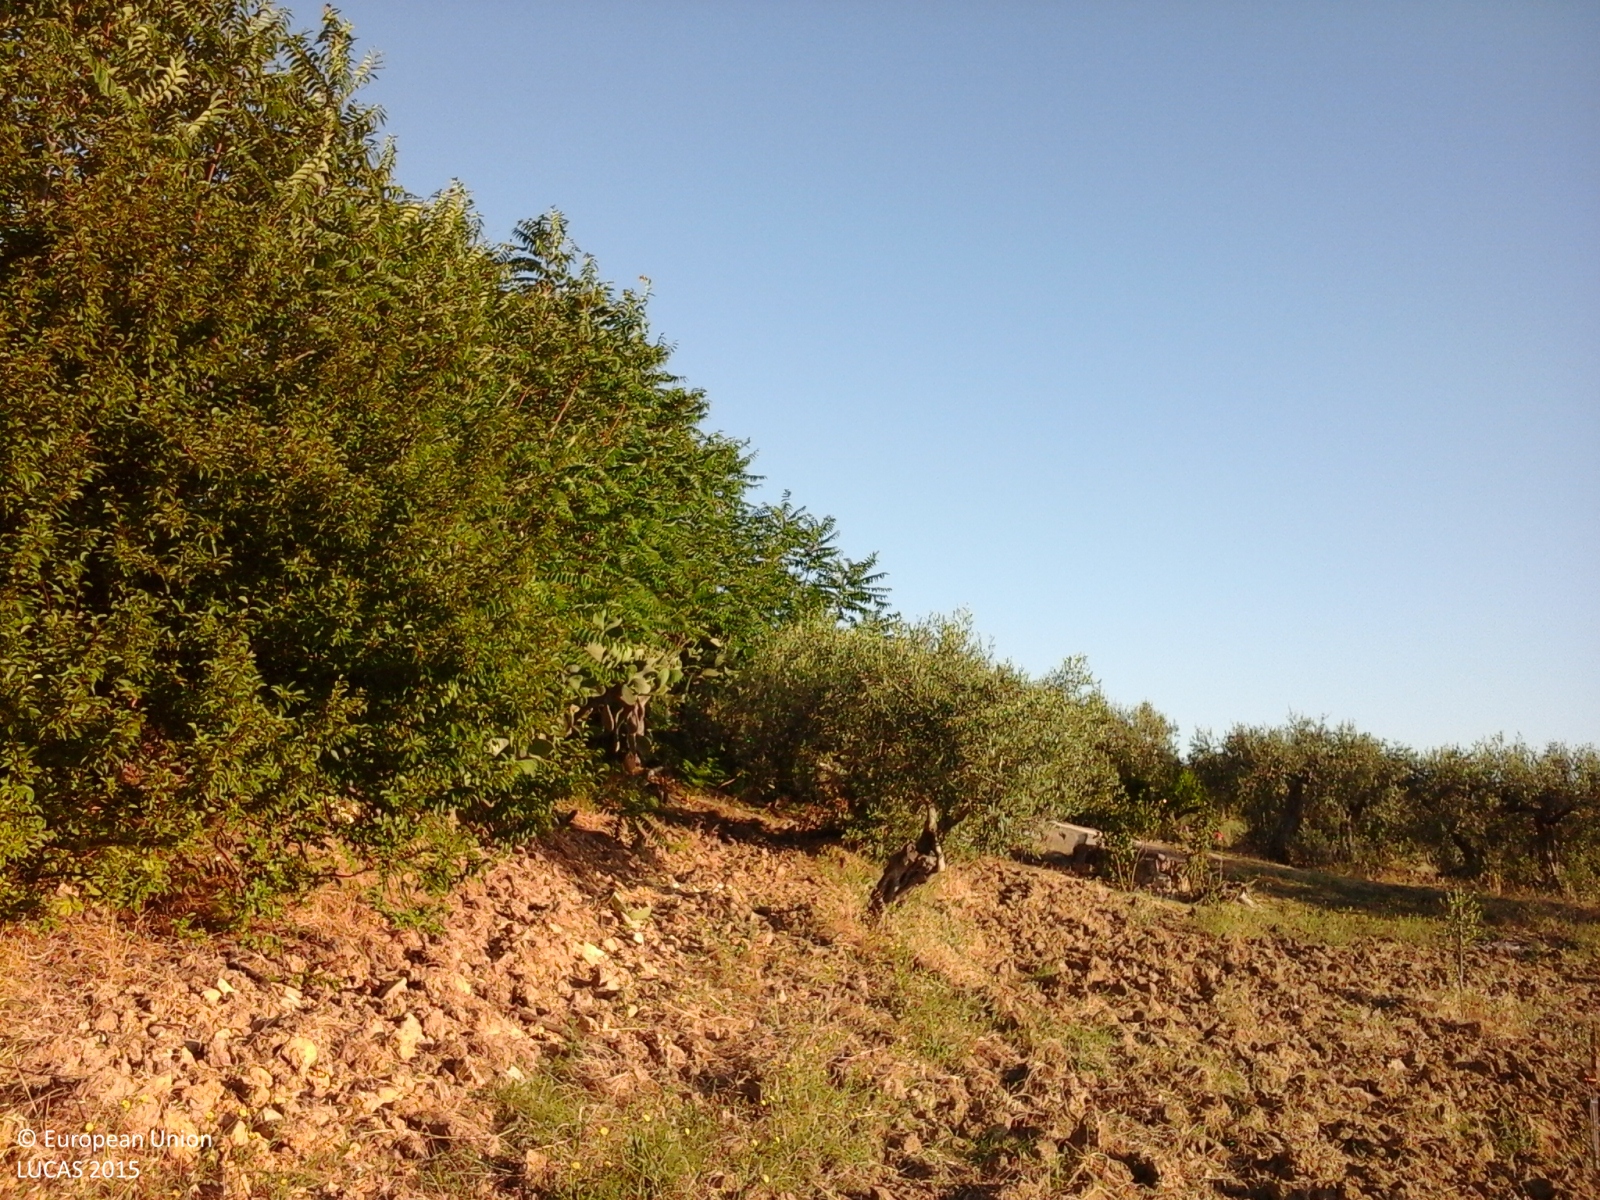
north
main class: Cropland
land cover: Olive groves
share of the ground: 10 - 25 %
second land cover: Other bare soil
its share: > 75 %
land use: Agriculture (excluding fallow land and kitchen gardens)
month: June
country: IT
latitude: 37.7056
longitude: 12.8257
